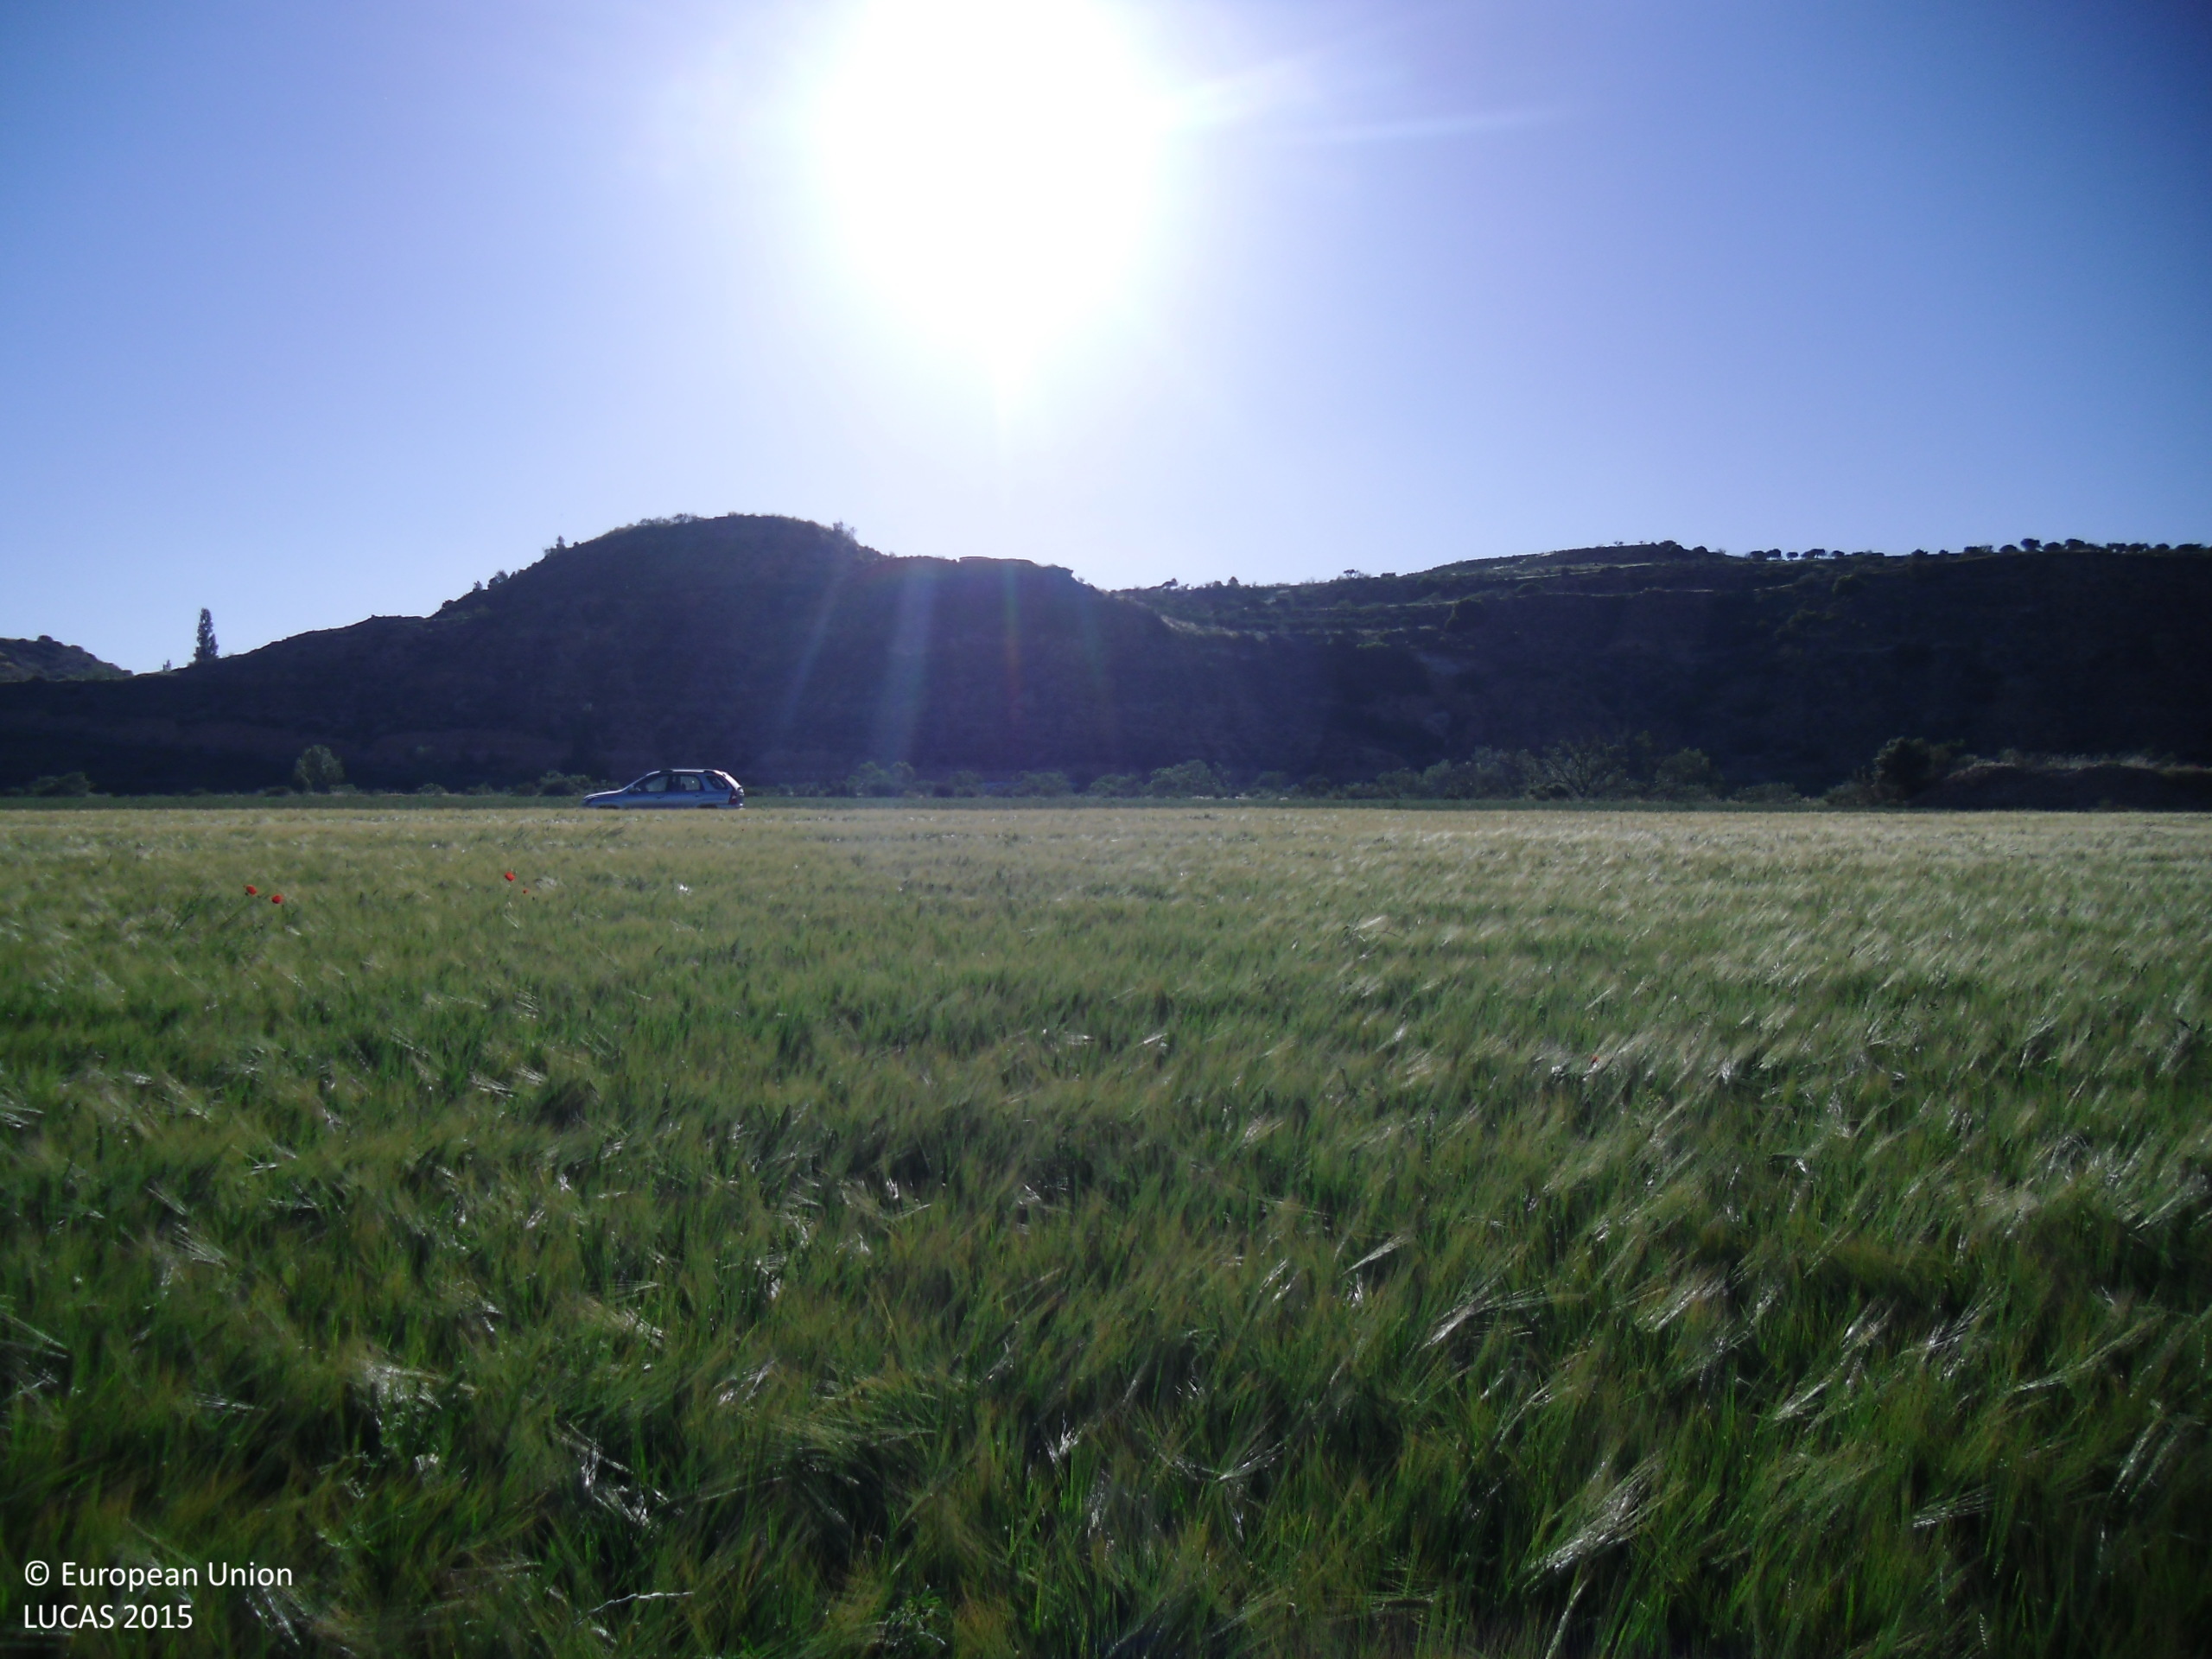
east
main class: Cropland
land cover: Barley
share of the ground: > 75 %
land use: Agriculture (excluding fallow land and kitchen gardens)
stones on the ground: > 50 %
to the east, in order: Barley; Grass margins; Tracks; Barley; Shrubland with sparse tree cover; Broadleaved woodland
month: May
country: ES
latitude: 40.3278
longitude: -2.8908
